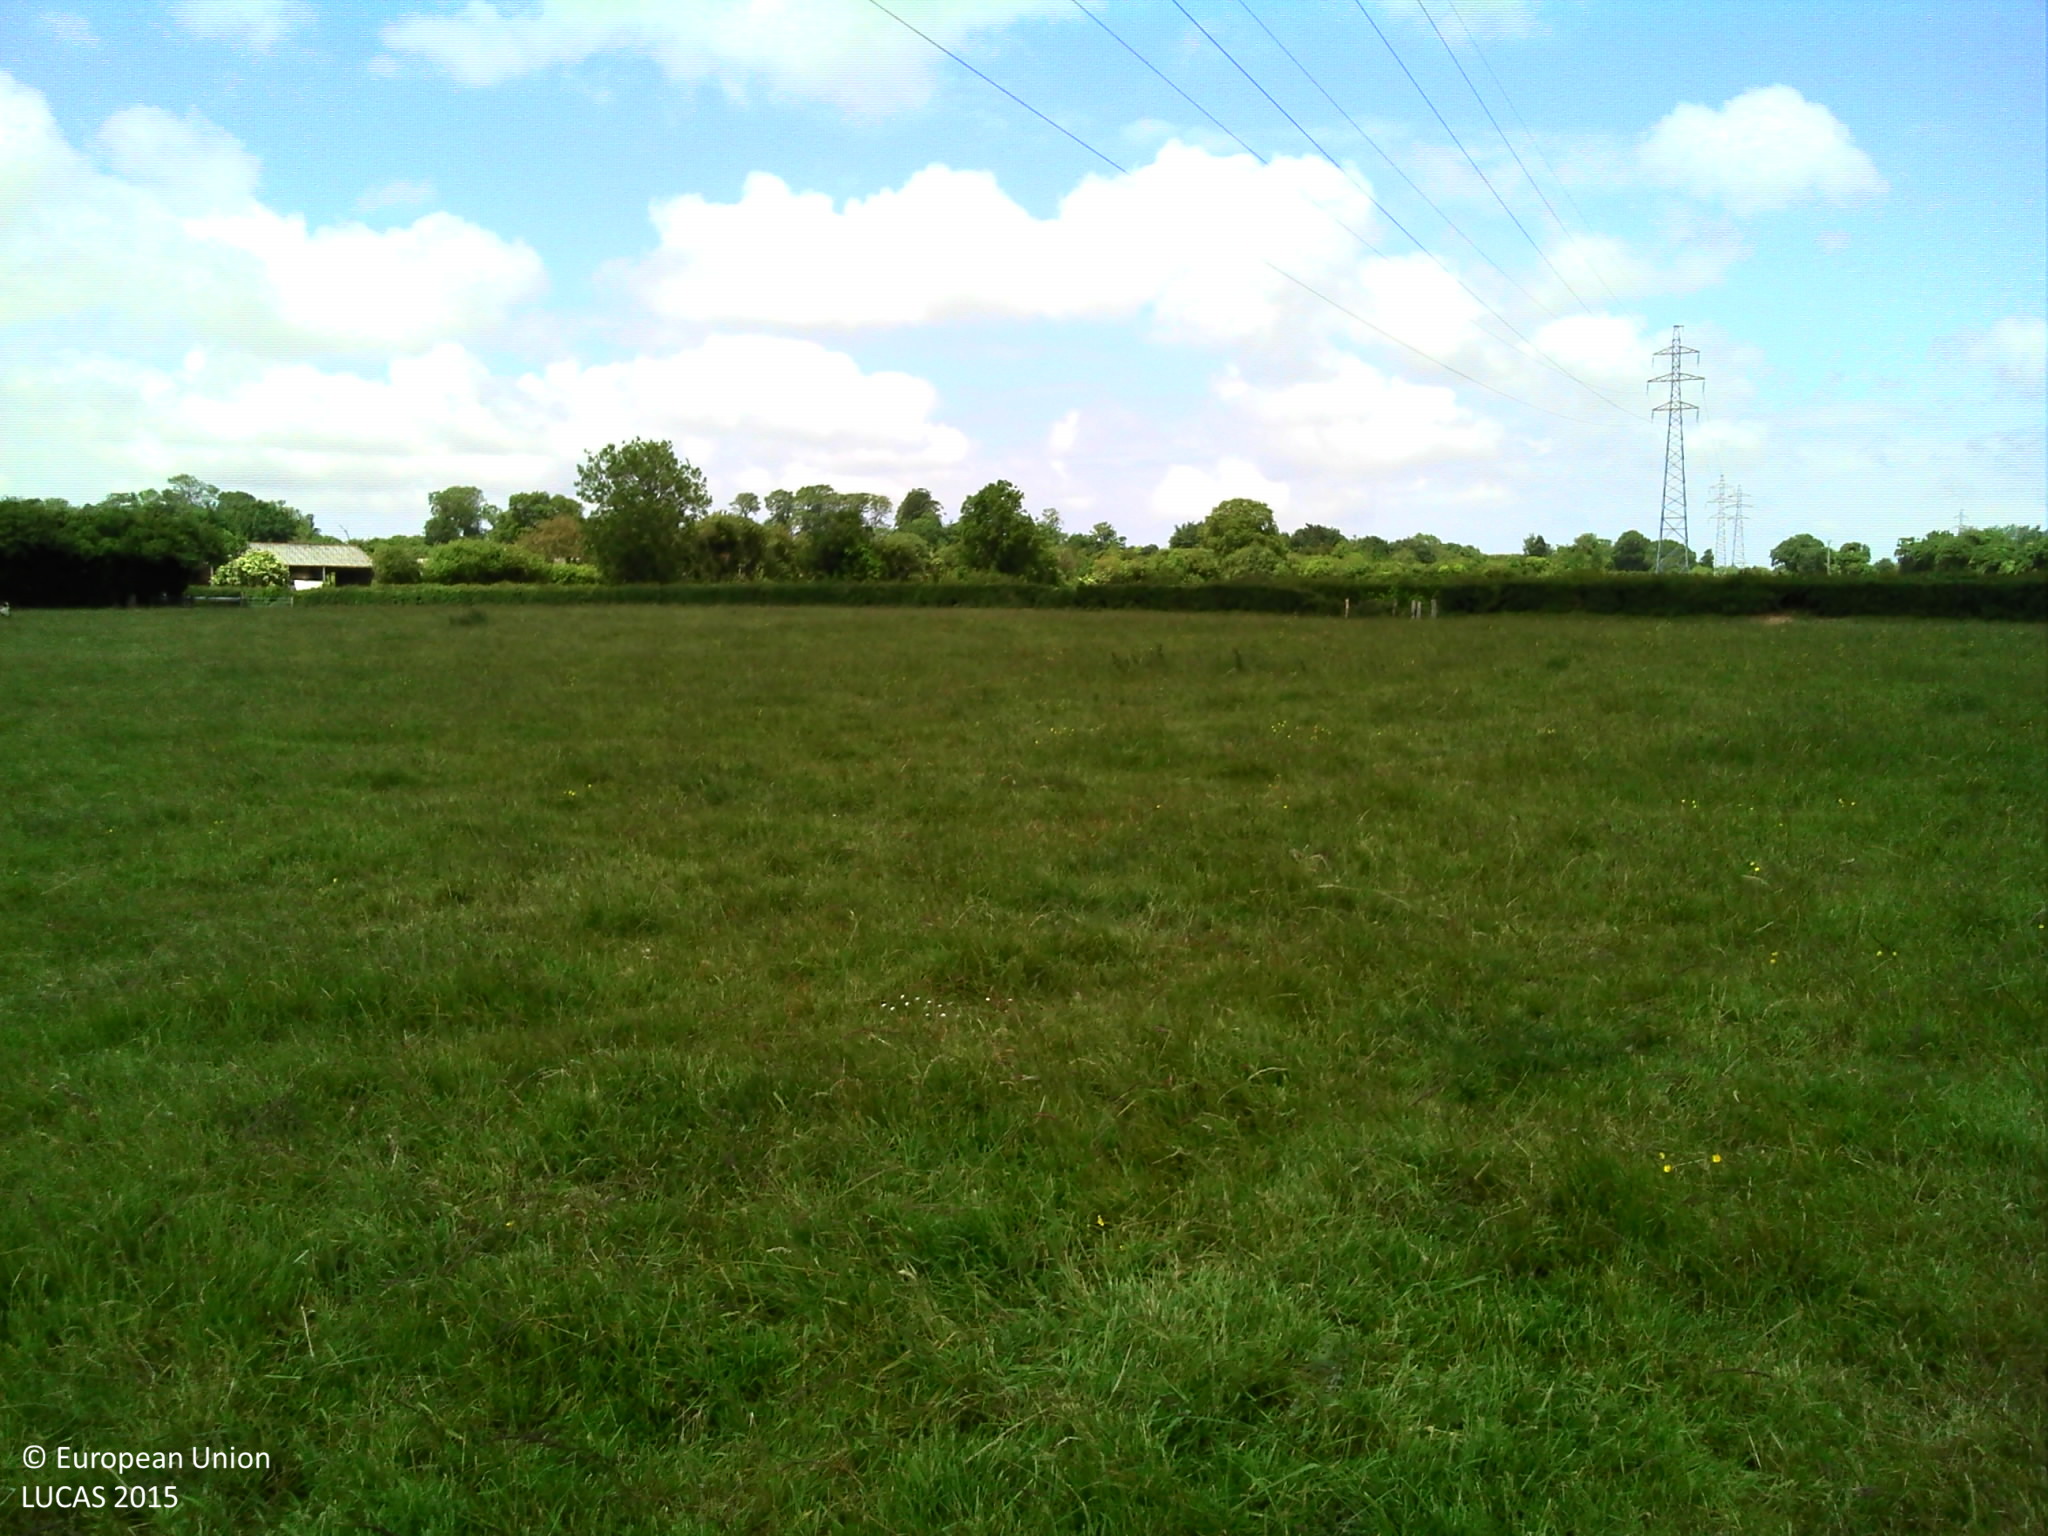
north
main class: Grassland
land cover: Grassland without tree/shrub cover
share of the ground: > 75 %
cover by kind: herbaceous plants 100 %
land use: Agriculture (excluding fallow land and kitchen gardens)
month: June
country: FR
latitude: 49.5710
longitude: -1.4291
